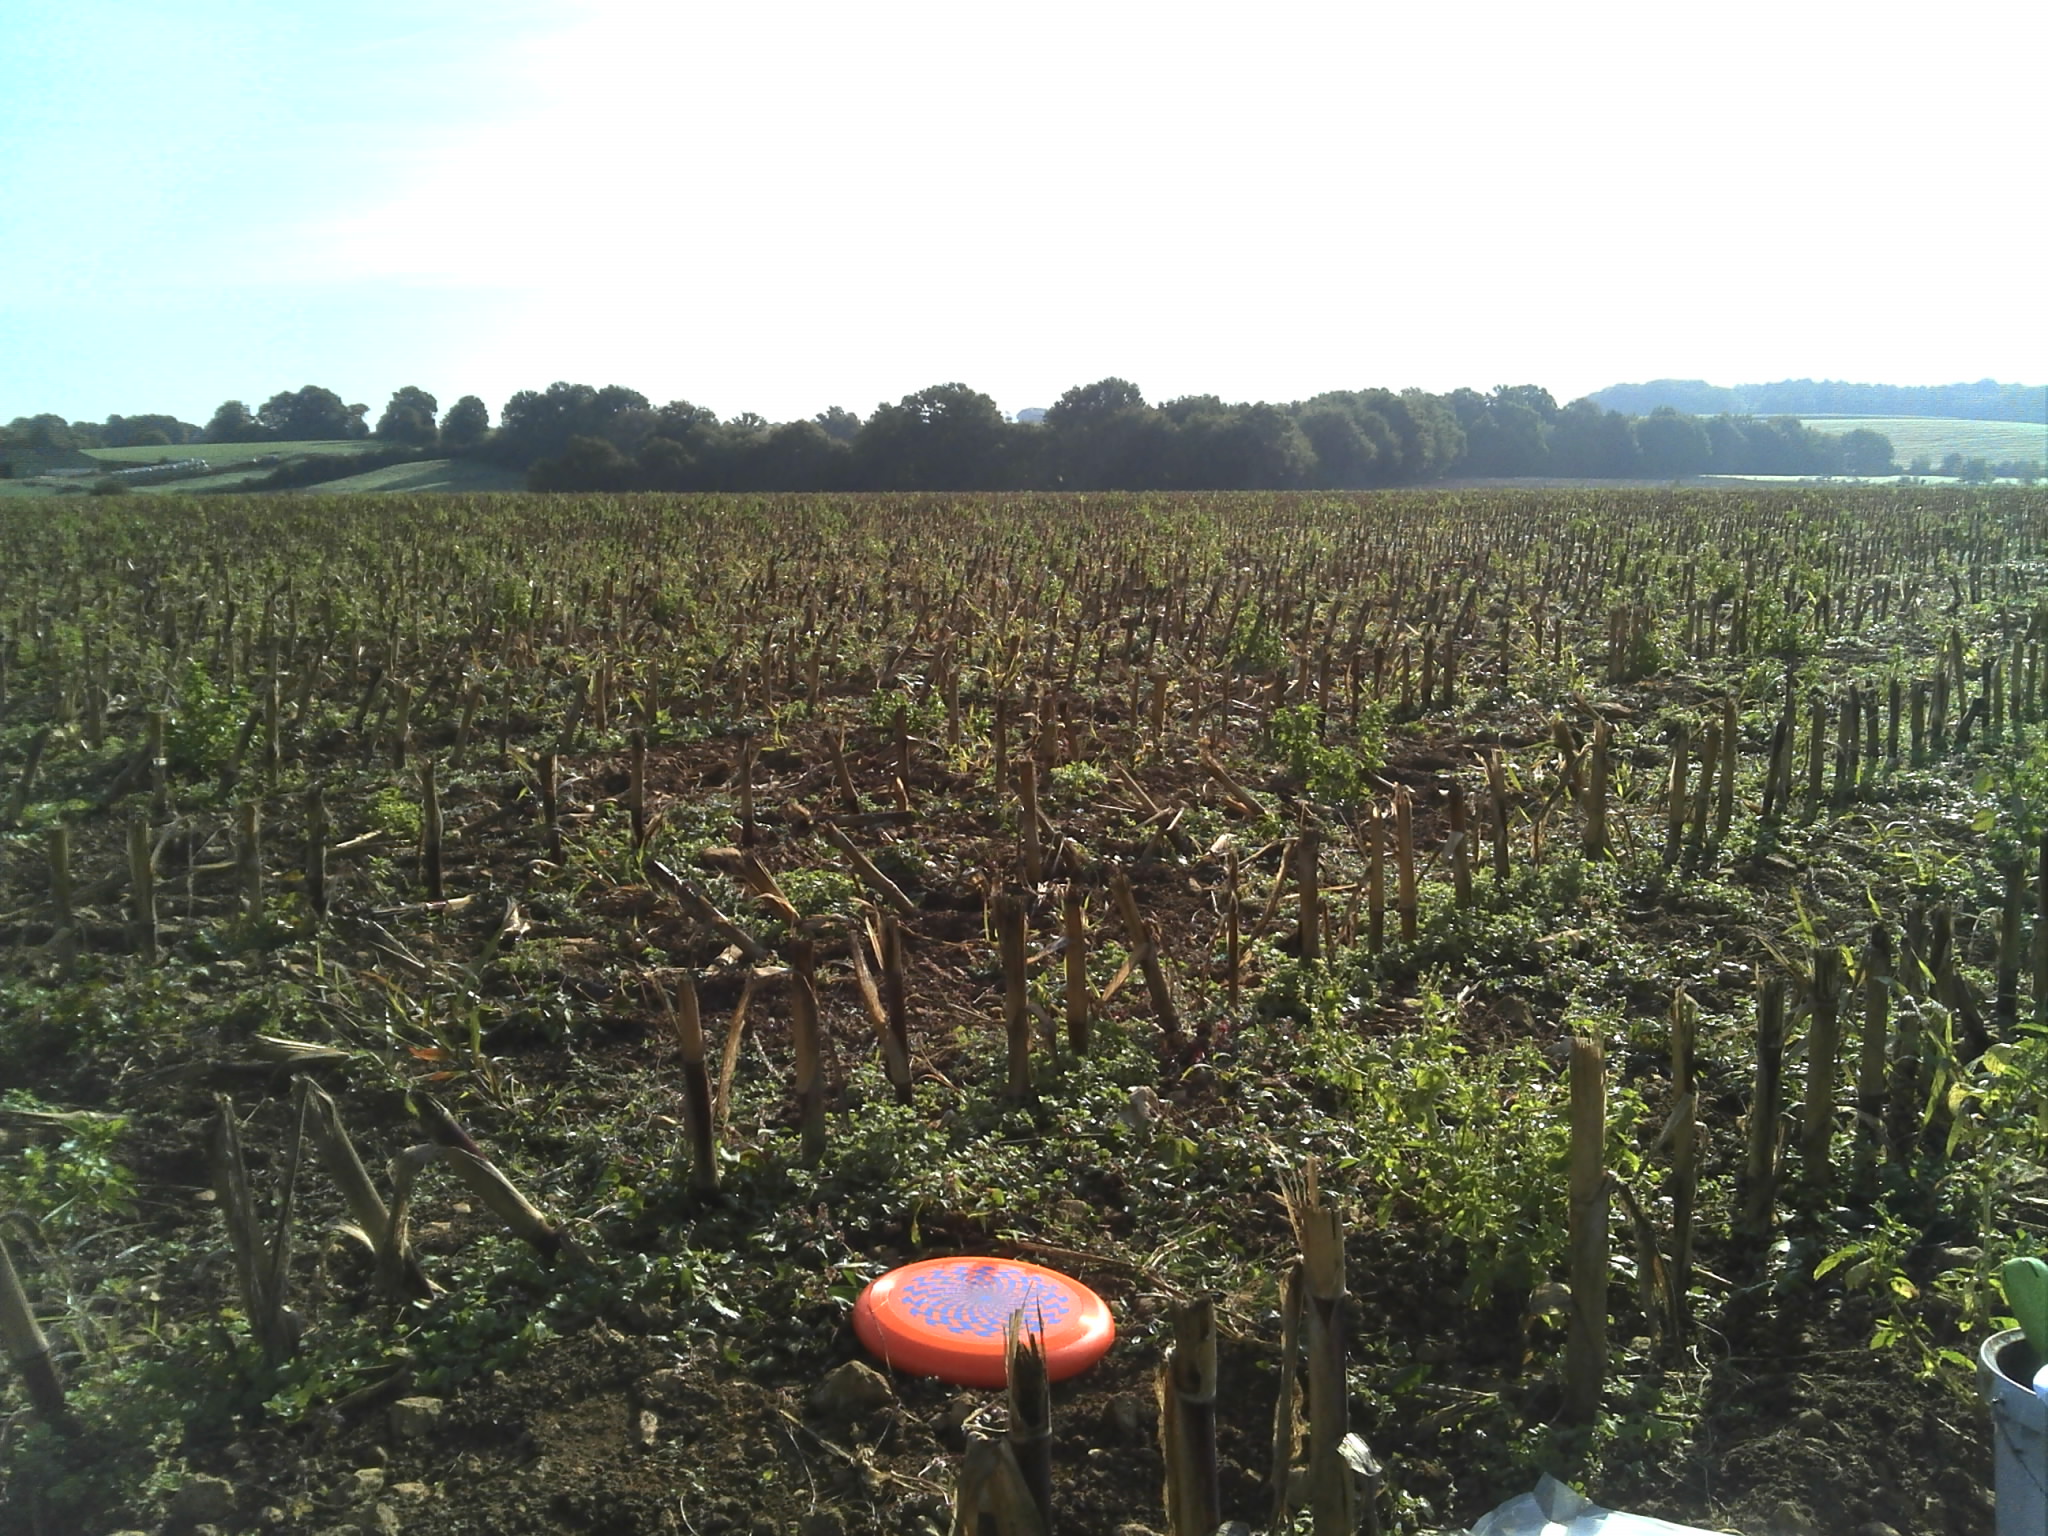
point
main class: Cropland
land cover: Maize
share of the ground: < 10 %
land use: Agriculture (excluding fallow land and kitchen gardens)
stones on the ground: 10 - 25 %
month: September
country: FR
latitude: 48.0898
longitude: 0.5654
